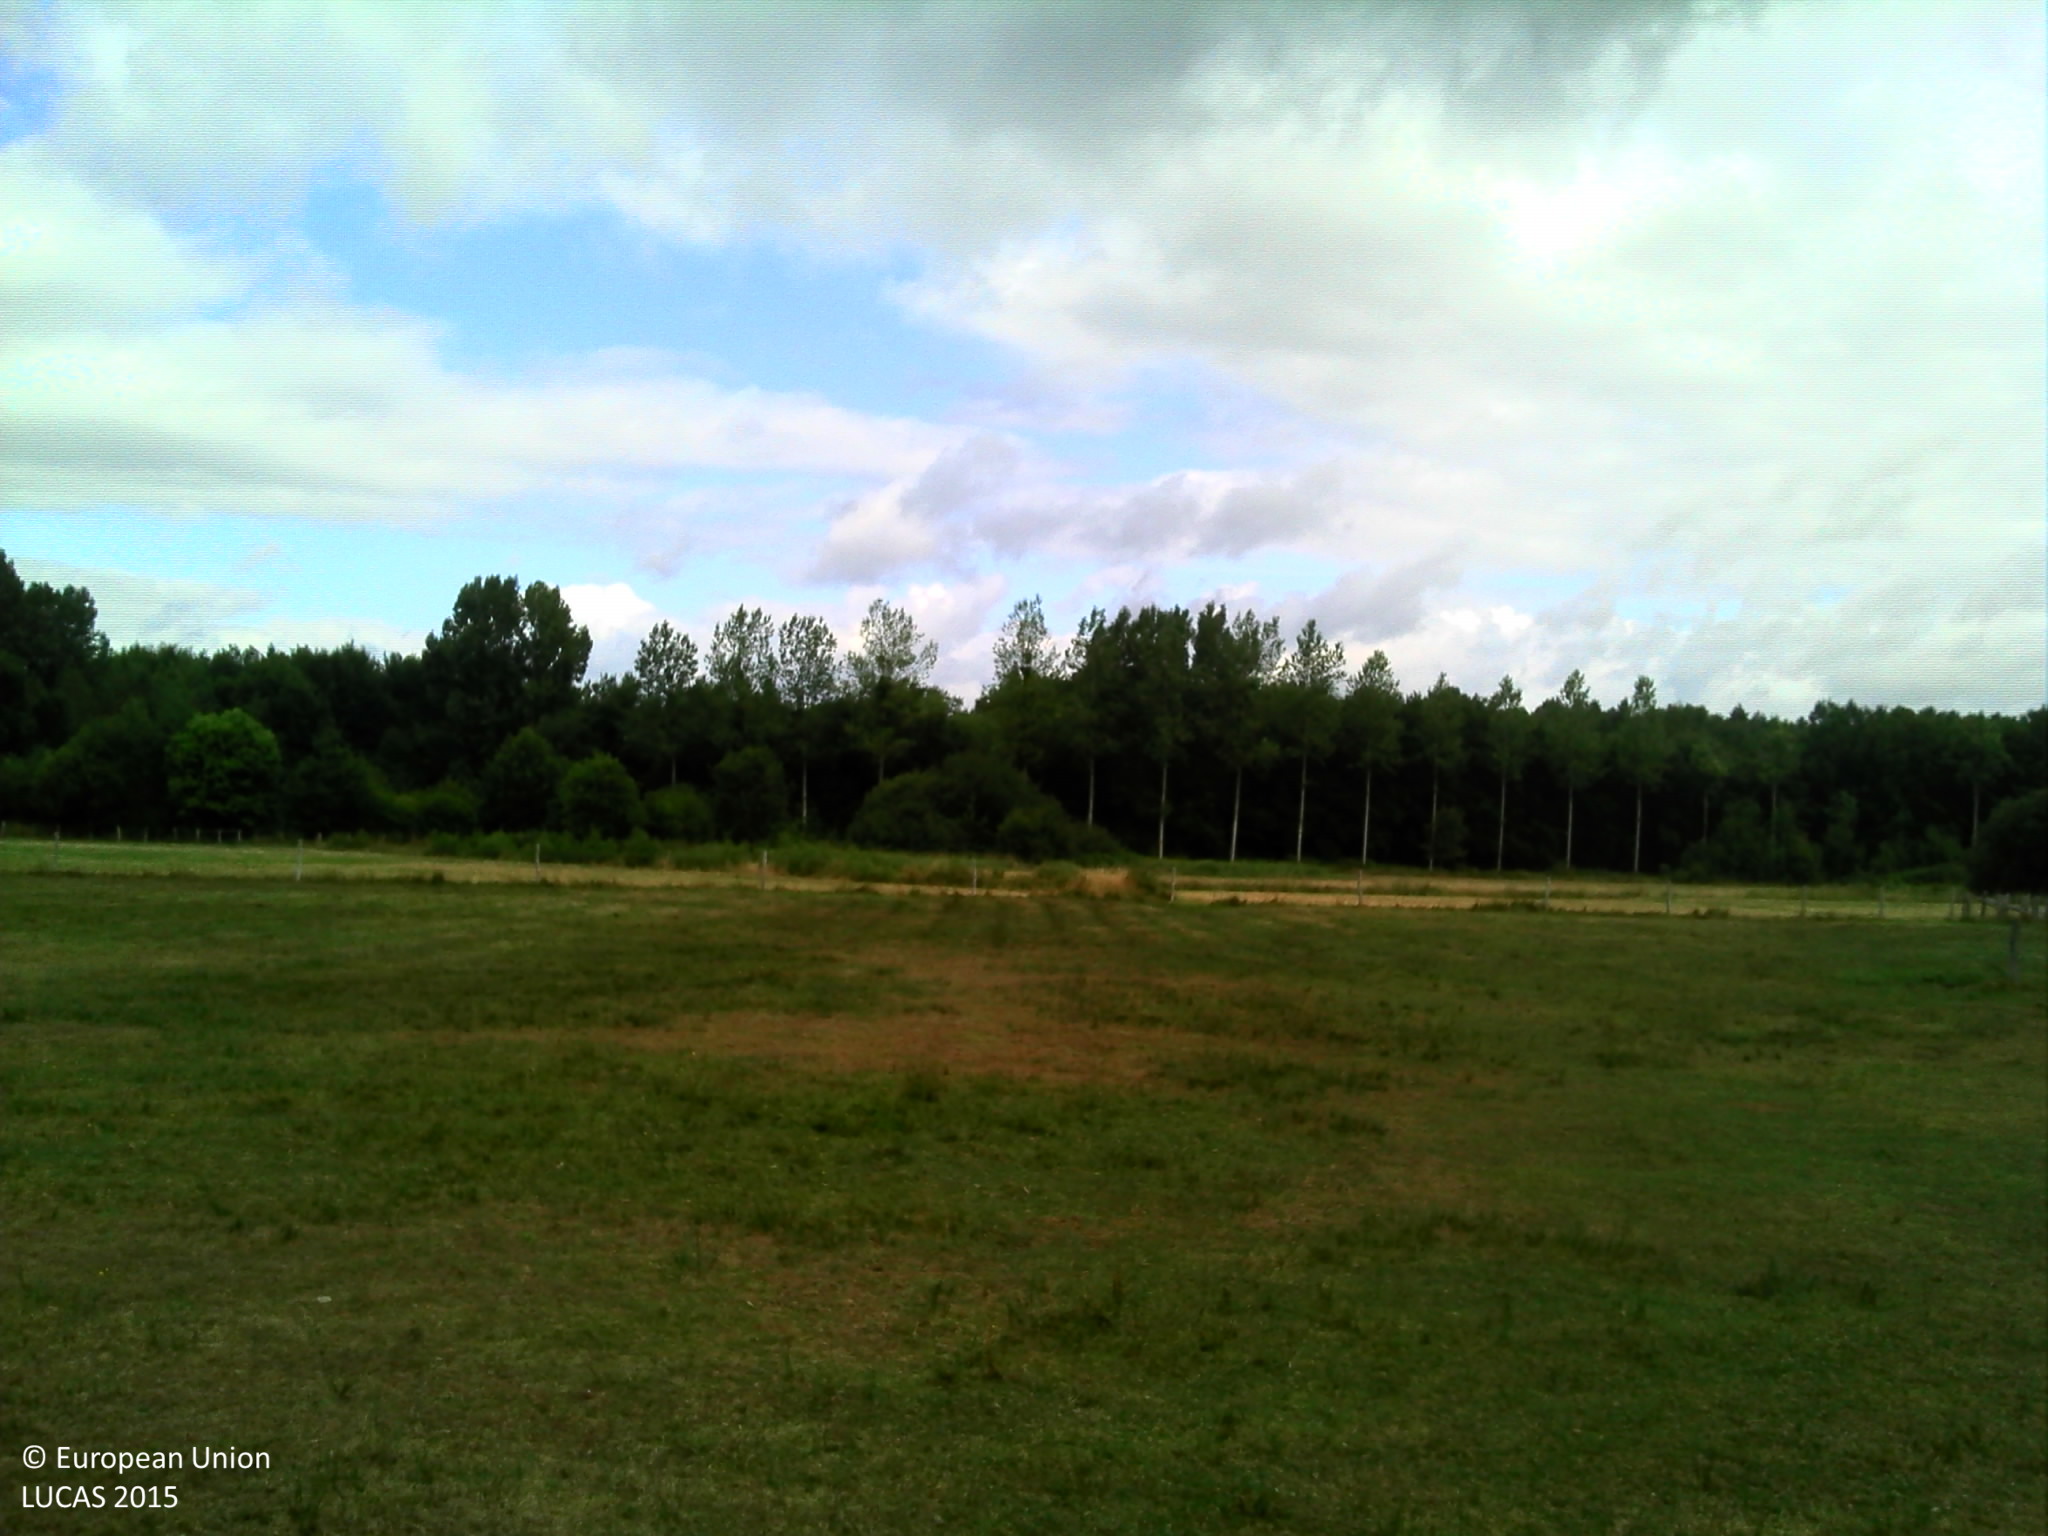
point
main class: Grassland
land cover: Grassland without tree/shrub cover
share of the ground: > 75 %
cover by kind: herbaceous plants 100 %
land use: Agriculture (excluding fallow land and kitchen gardens)
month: July
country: FR
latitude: 47.8077
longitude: 0.2406
